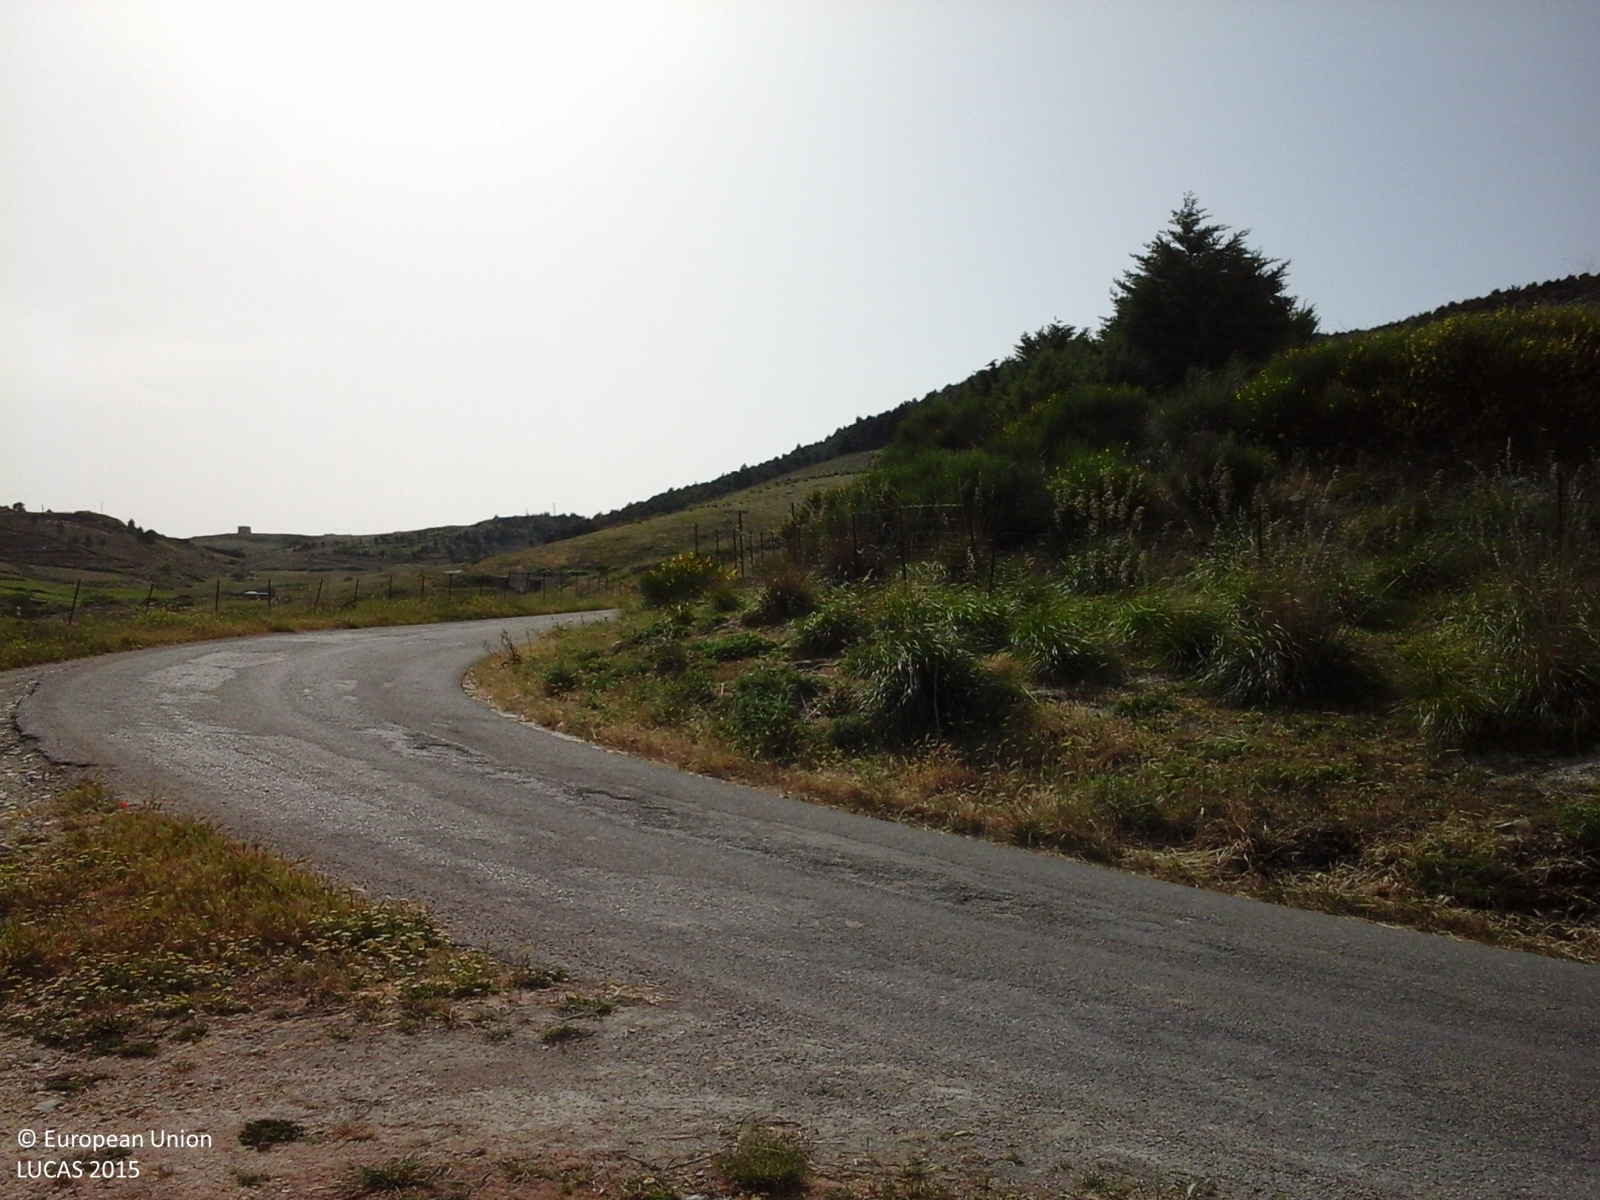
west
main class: Shrubland
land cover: Shrubland with sparse tree cover
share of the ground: > 75 %
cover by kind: shrubs 95 %, broadleaved forest trees 5 %
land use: Agriculture (excluding fallow land and kitchen gardens)
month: May
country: IT
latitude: 37.6279
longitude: 13.5203
